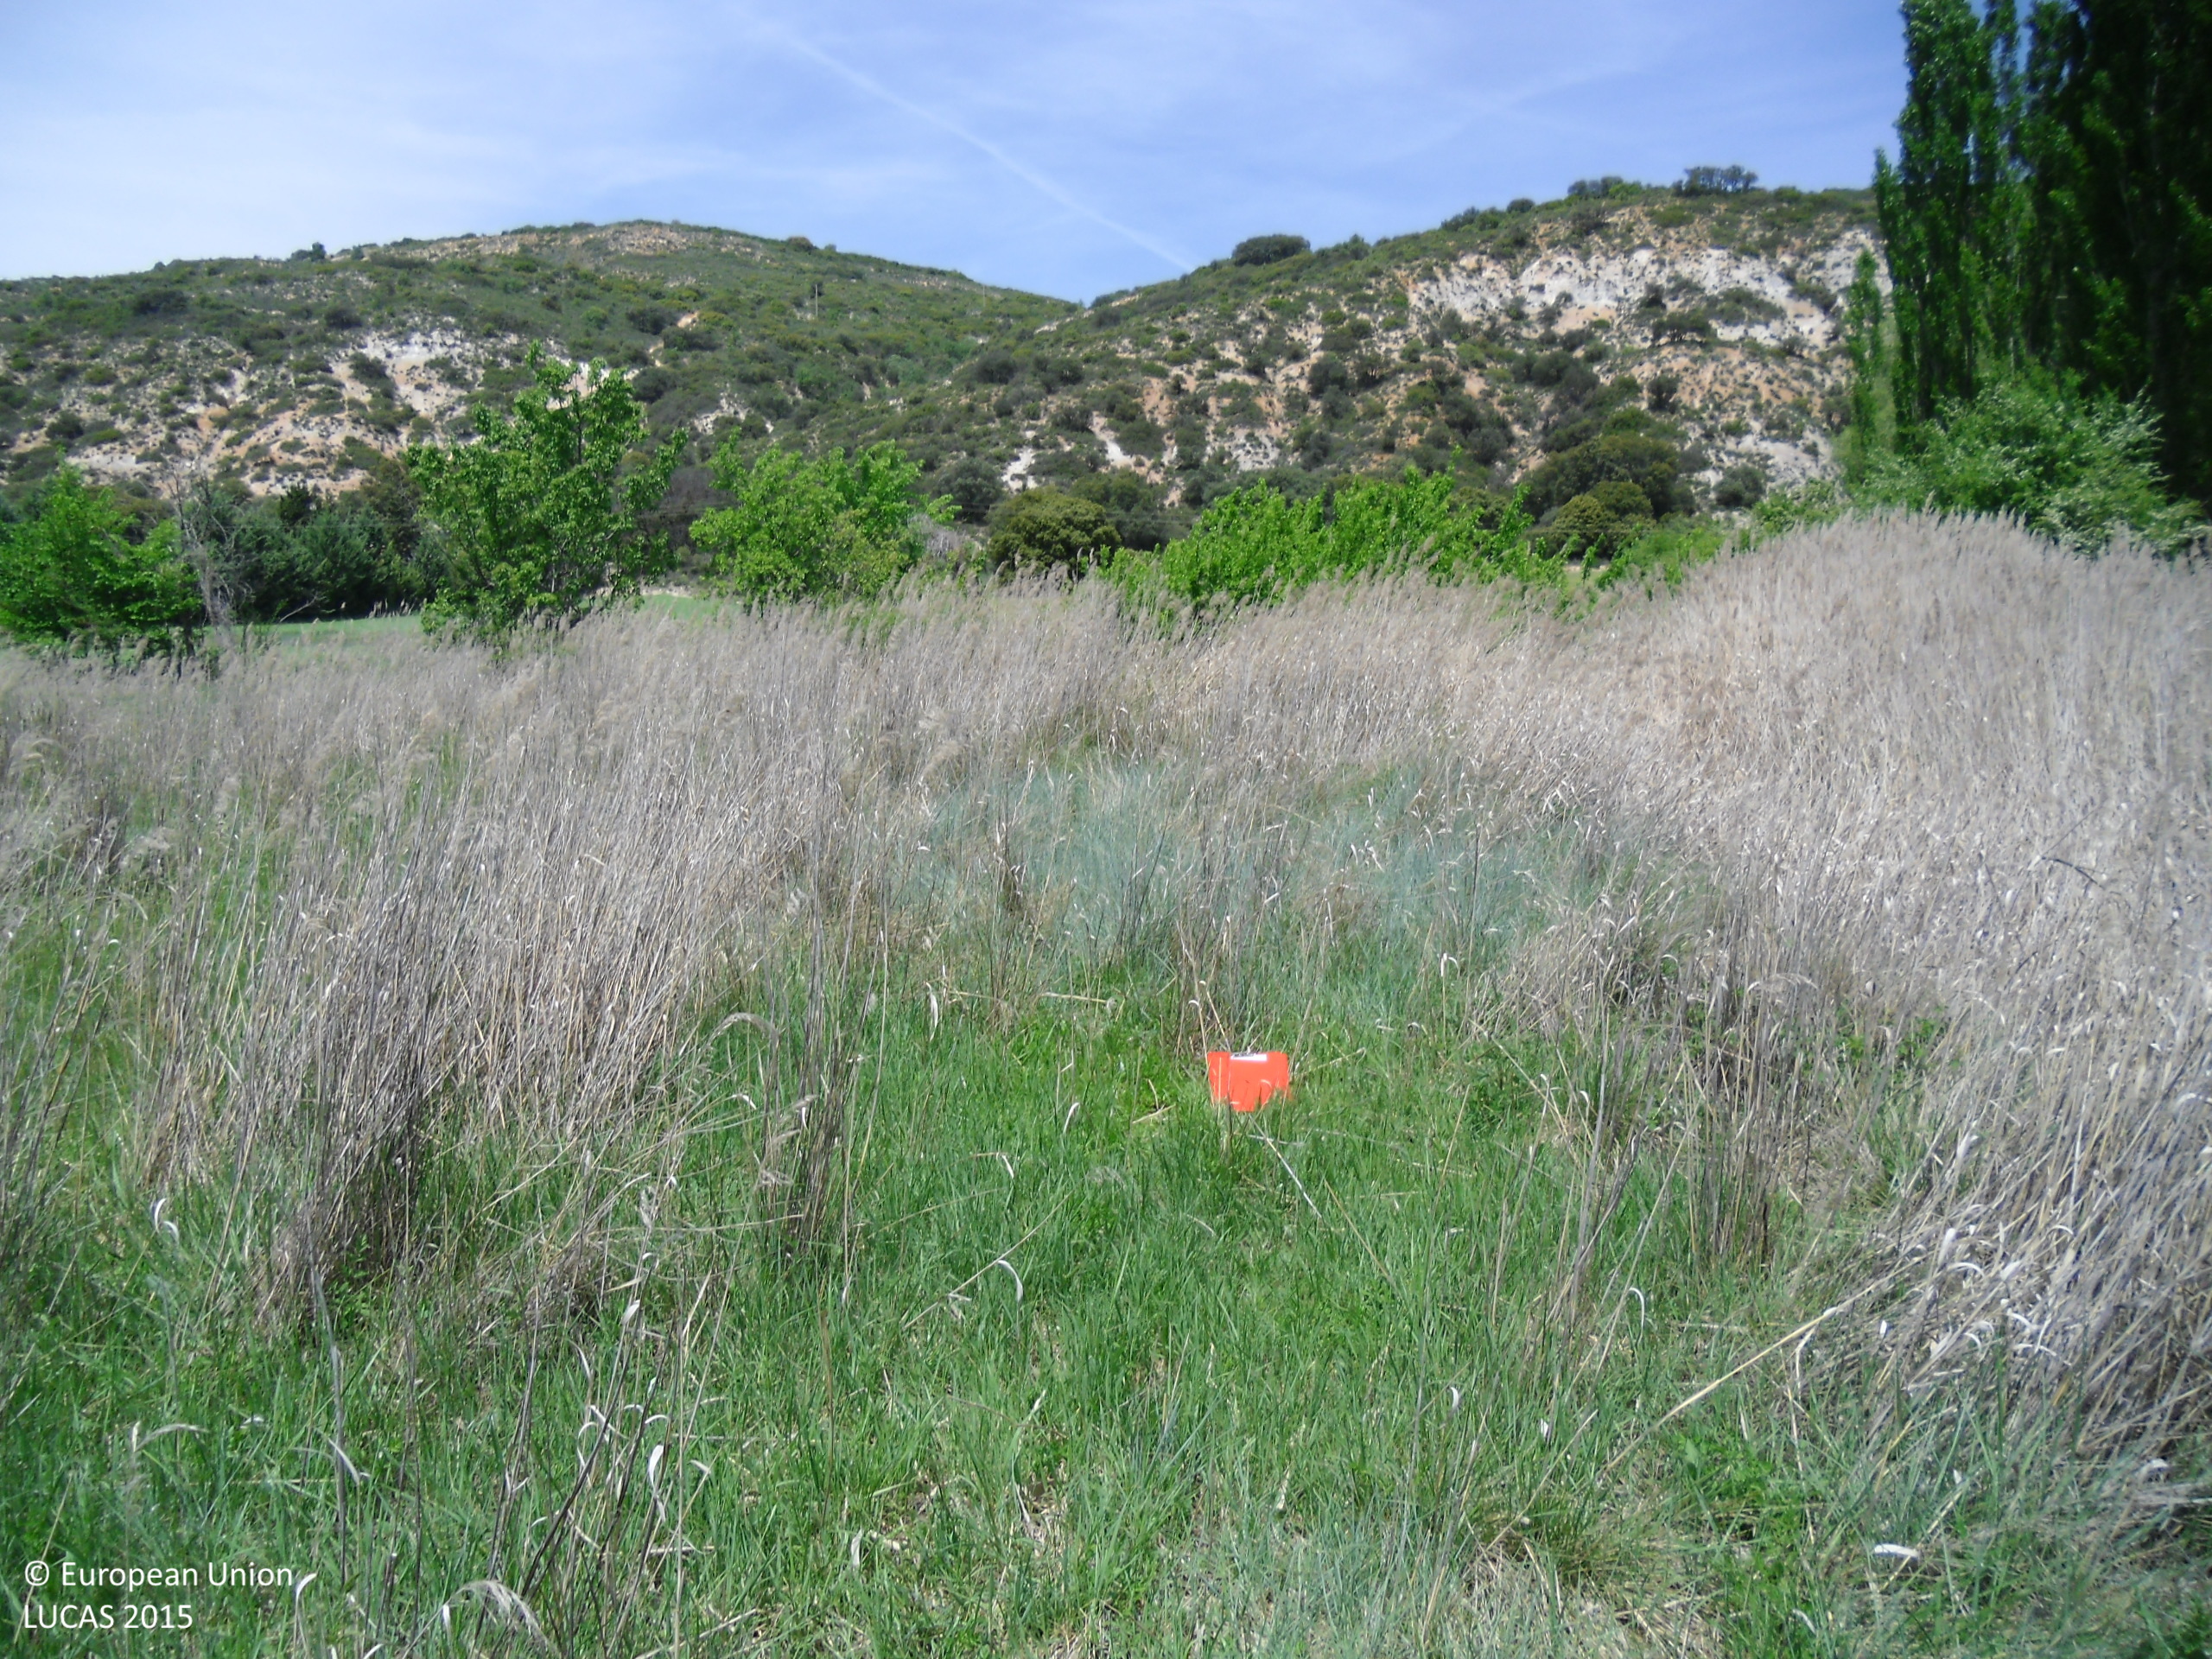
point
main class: Grassland
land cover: Grassland without tree/shrub cover
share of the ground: > 75 %
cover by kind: herbaceous plants 100 %
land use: Semi-natural and natural areas not in use
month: May
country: ES
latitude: 40.4965
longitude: -2.9970
